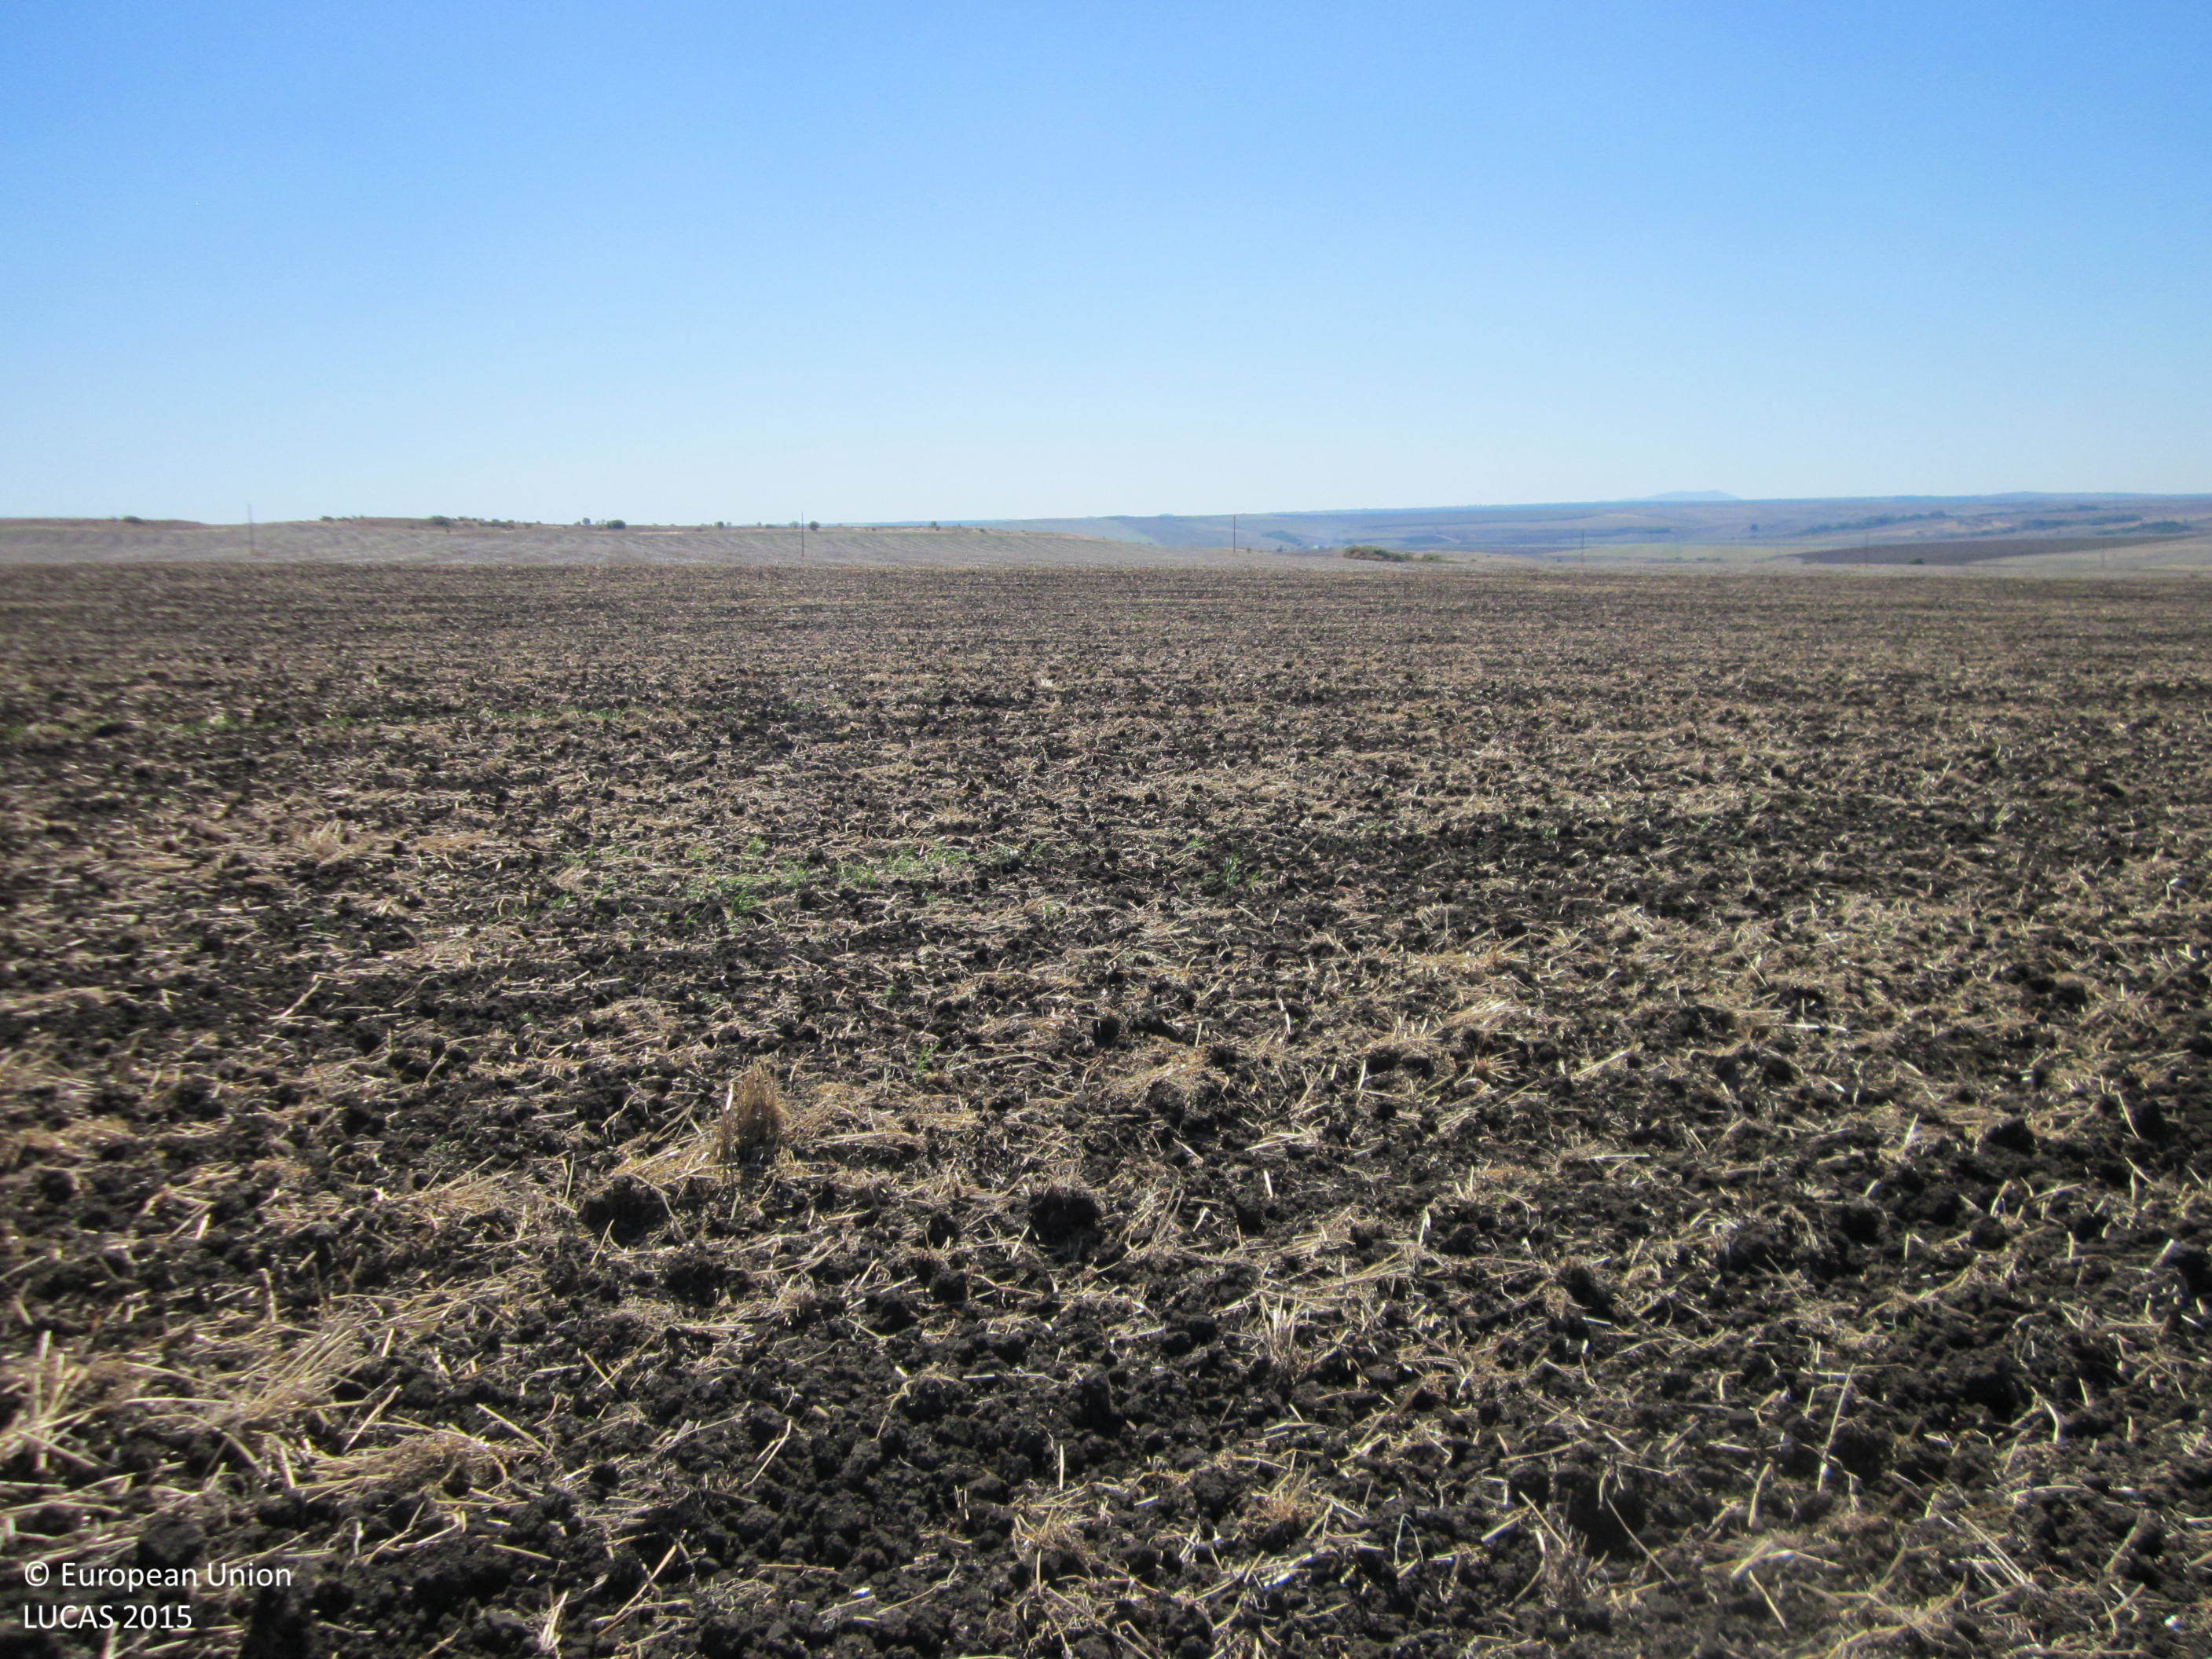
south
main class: Cropland
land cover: Common wheat
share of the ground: 10 - 25 %
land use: Agriculture (excluding fallow land and kitchen gardens)
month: September
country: BG
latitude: 42.5587
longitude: 27.0490
